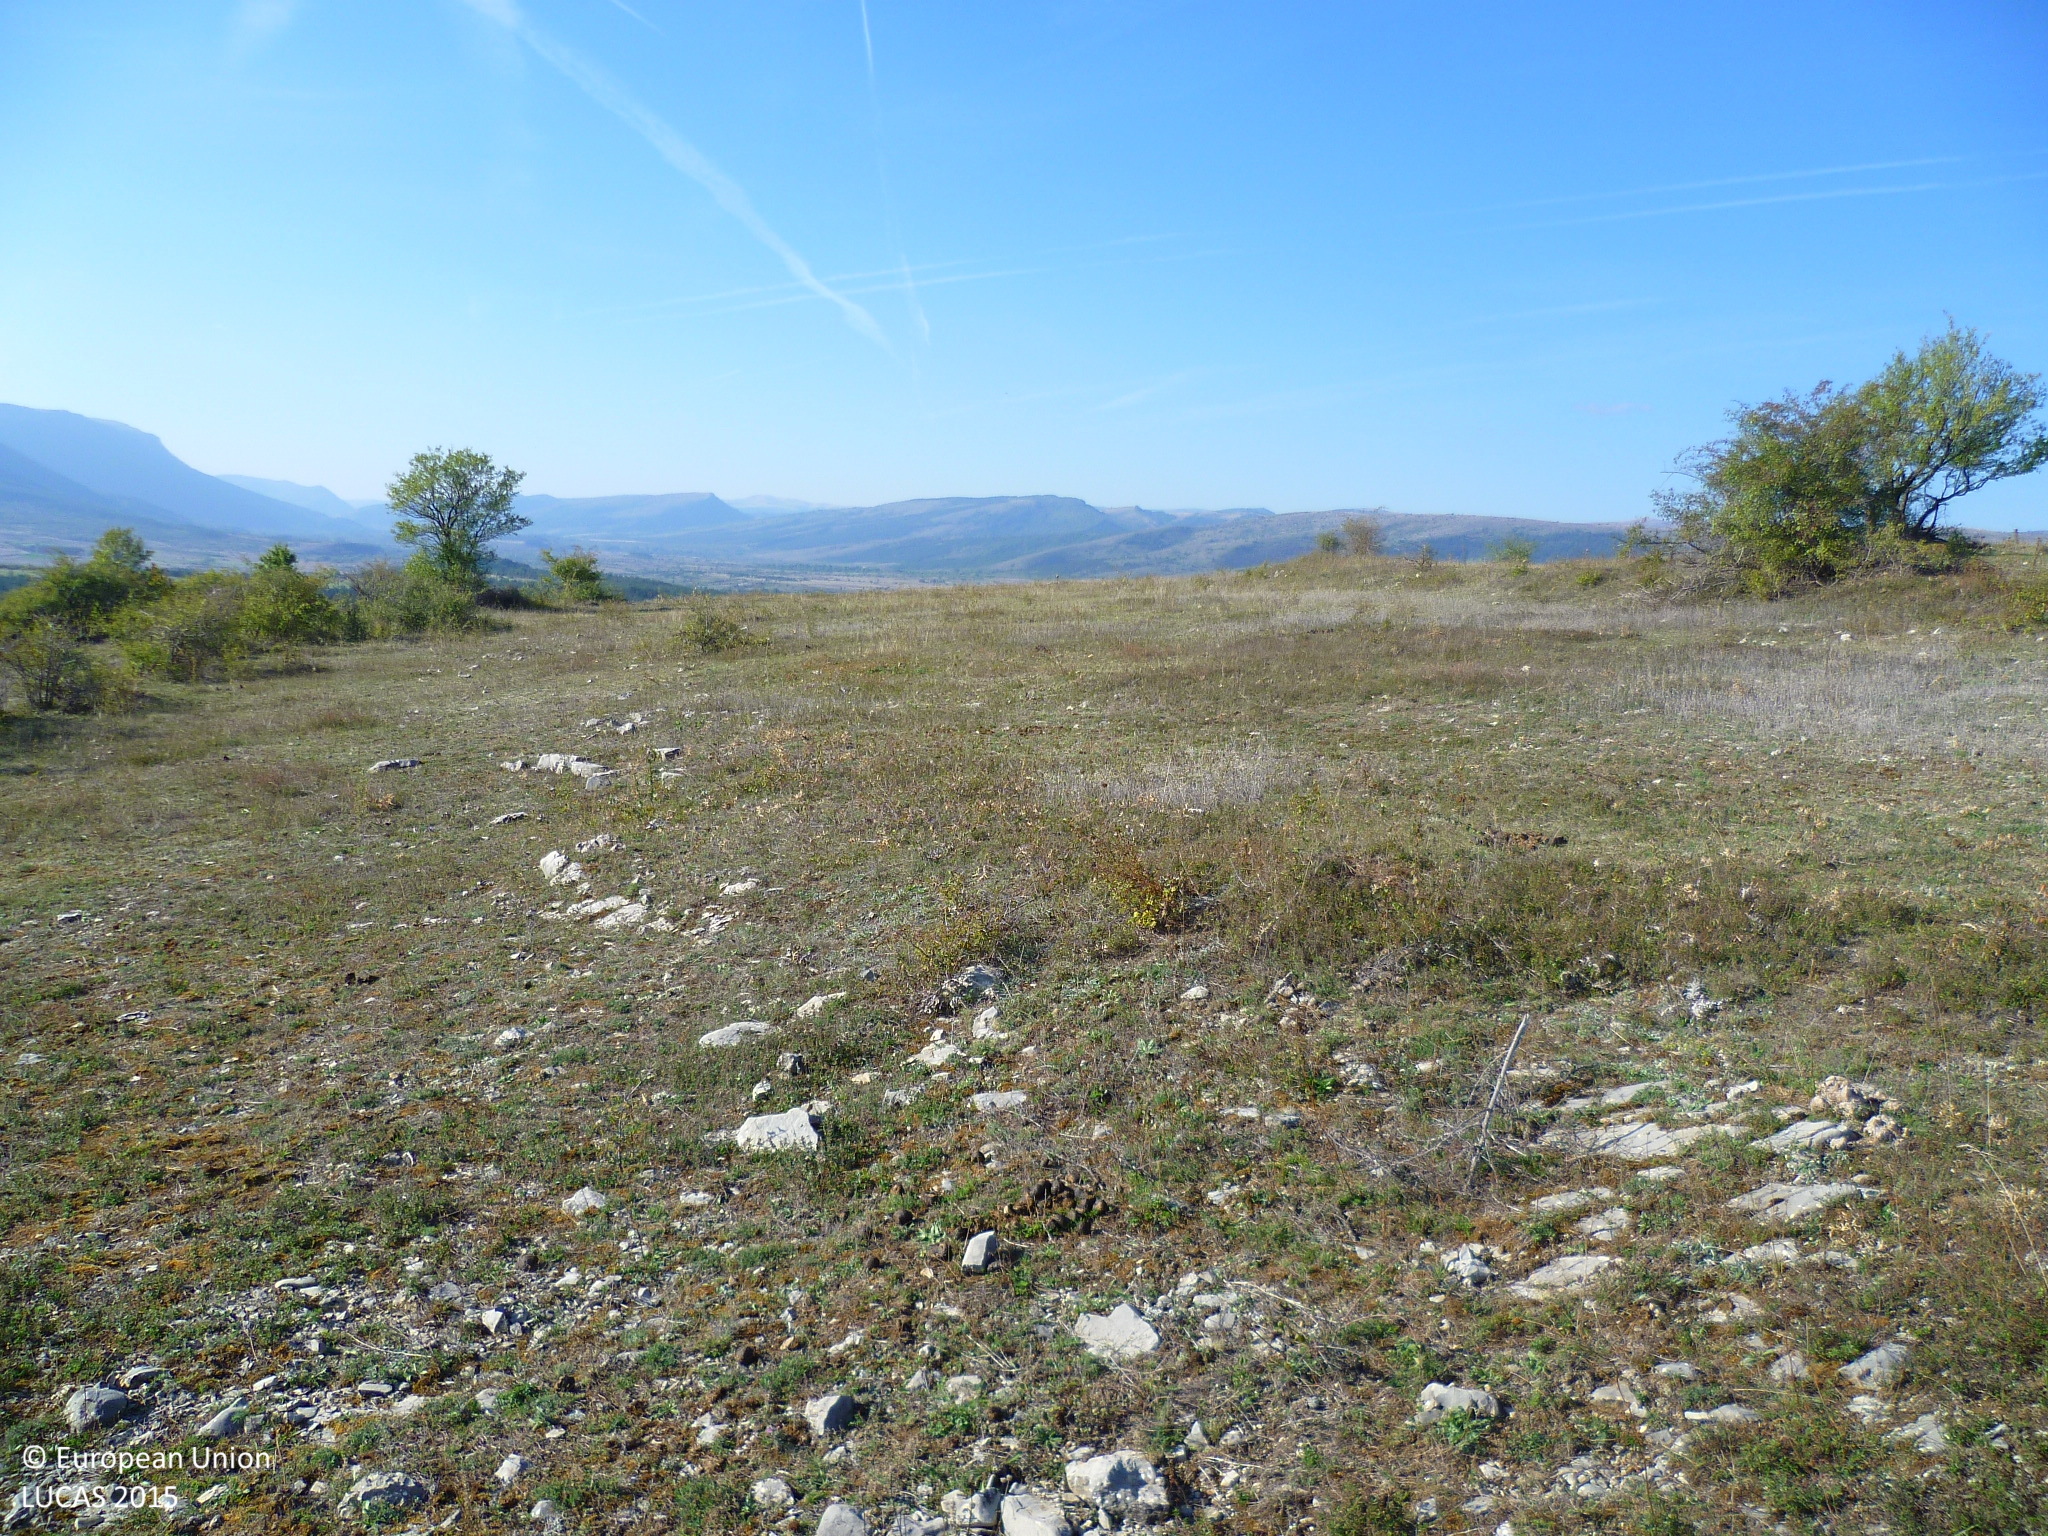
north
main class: Grassland
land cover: Grassland with sparse tree/shrub cover
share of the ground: > 75 %
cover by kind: herbaceous plants 65 %, unconsolidated bare surface 20 %, shrubs 10 %, broadleaved forest trees 5 %
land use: Agriculture (excluding fallow land and kitchen gardens)
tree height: < 5 m
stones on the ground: 25 - 50 %
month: October
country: BG
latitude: 43.0769
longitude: 22.9659
